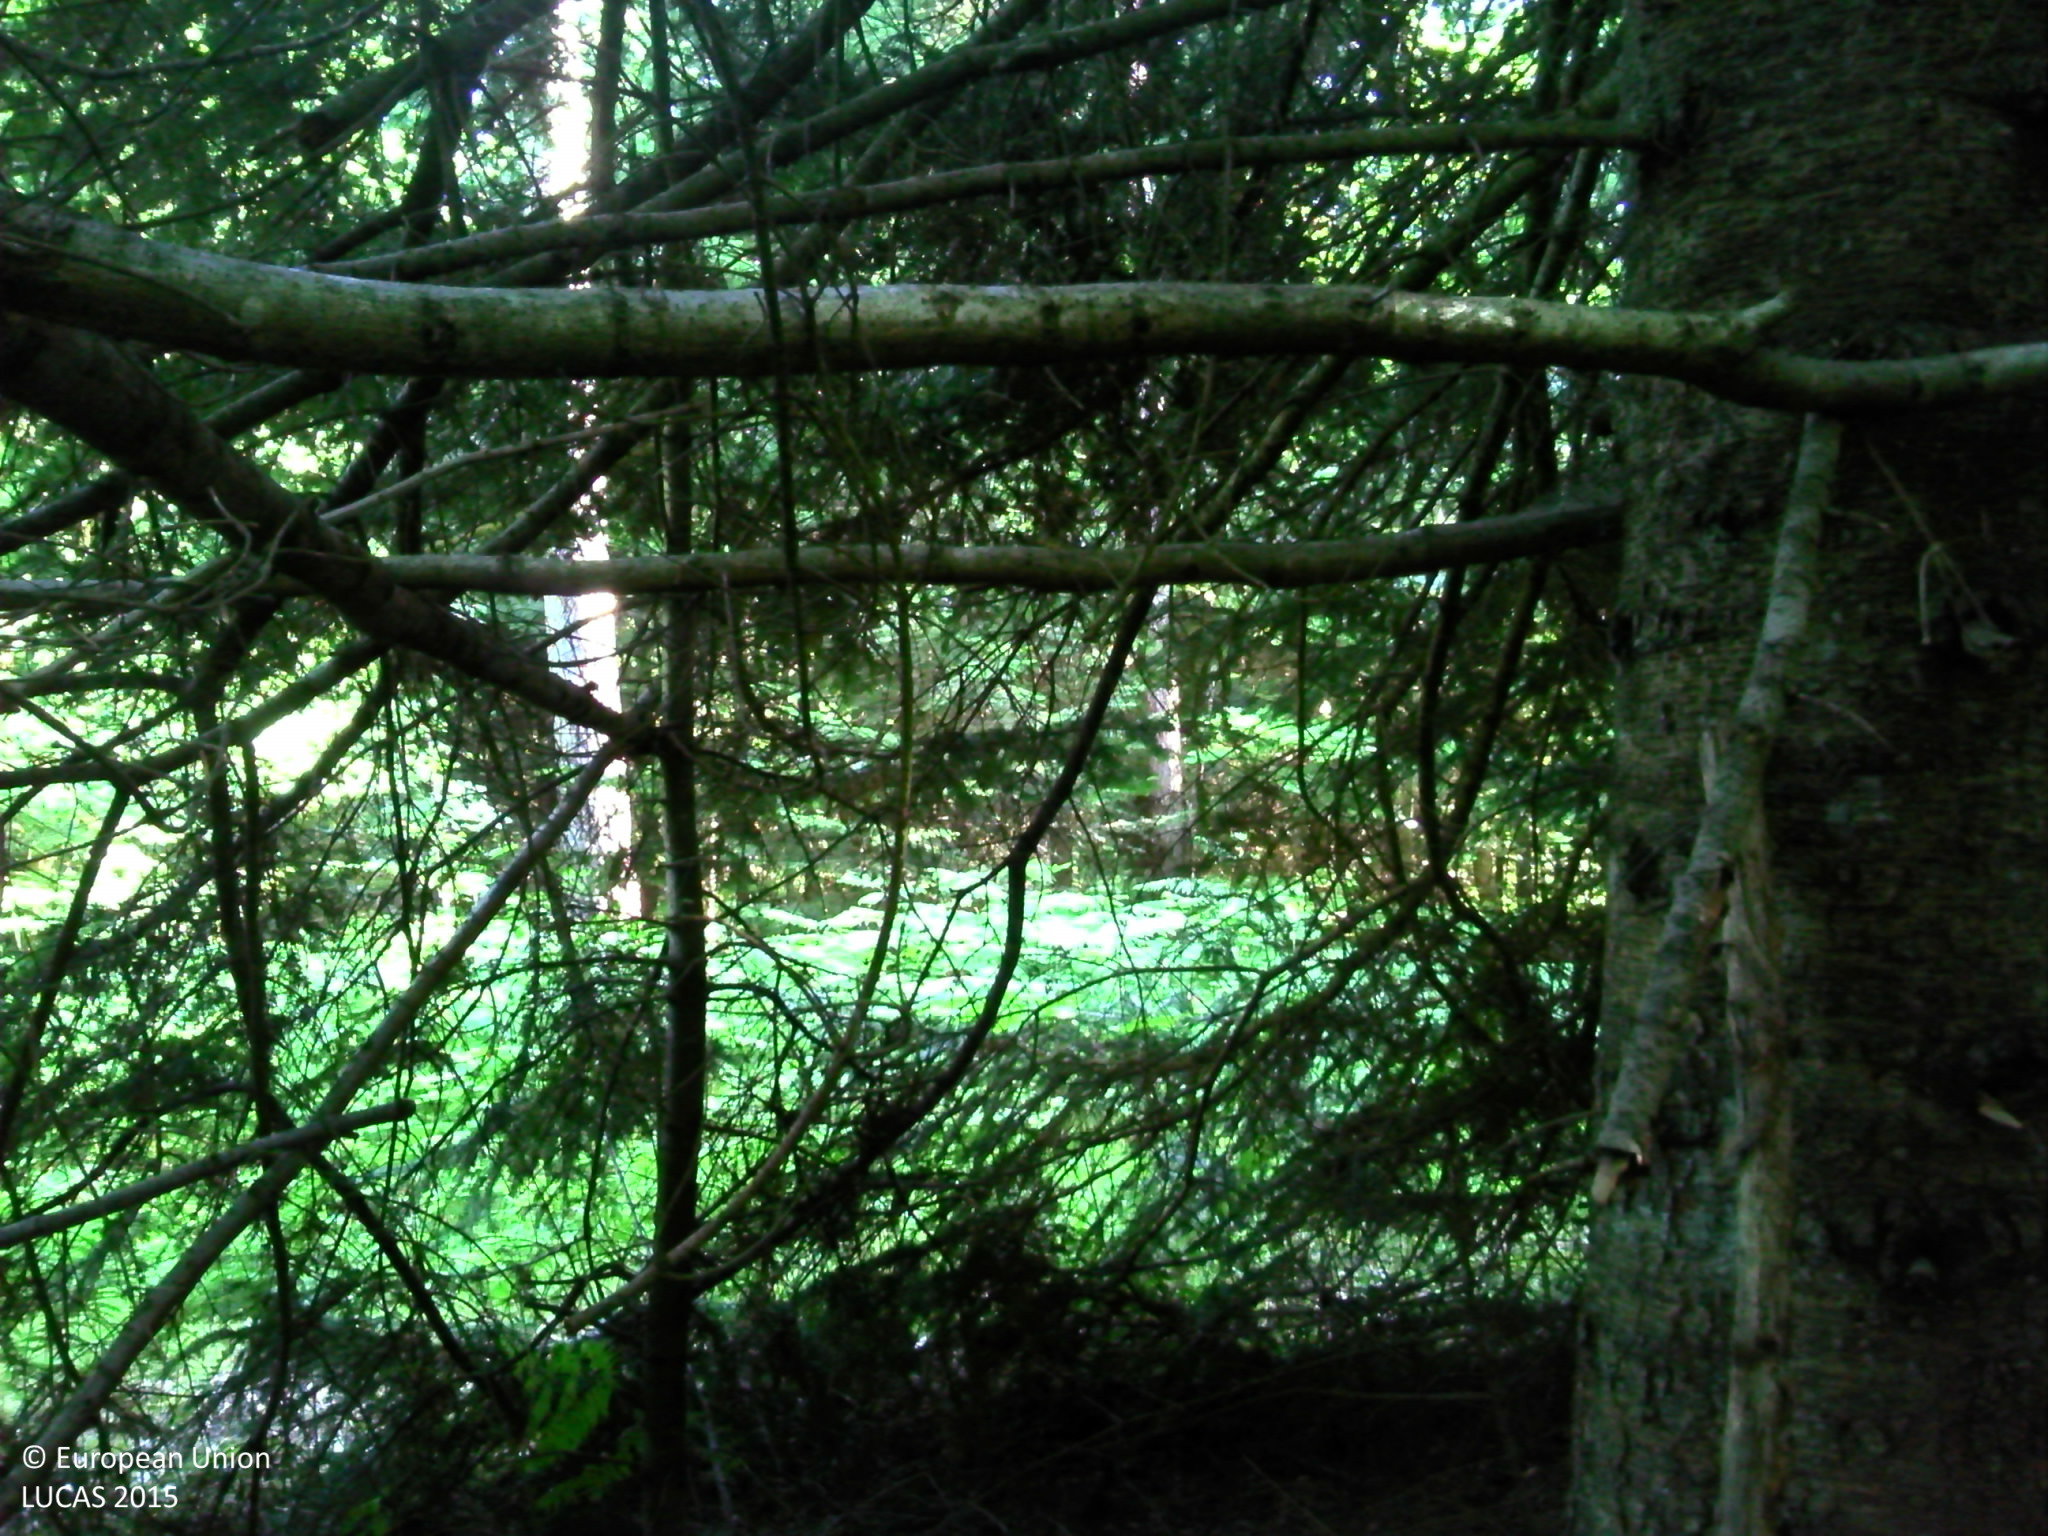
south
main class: Woodland
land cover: Other coniferous woodland
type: alpine coniferous forest
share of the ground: > 75 %
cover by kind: coniferous forest trees 90 %, herbaceous plants 5 %, lichens and mosses 5 %
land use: Forestry
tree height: > 5 m
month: July
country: FR
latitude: 44.9965
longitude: 3.4960
